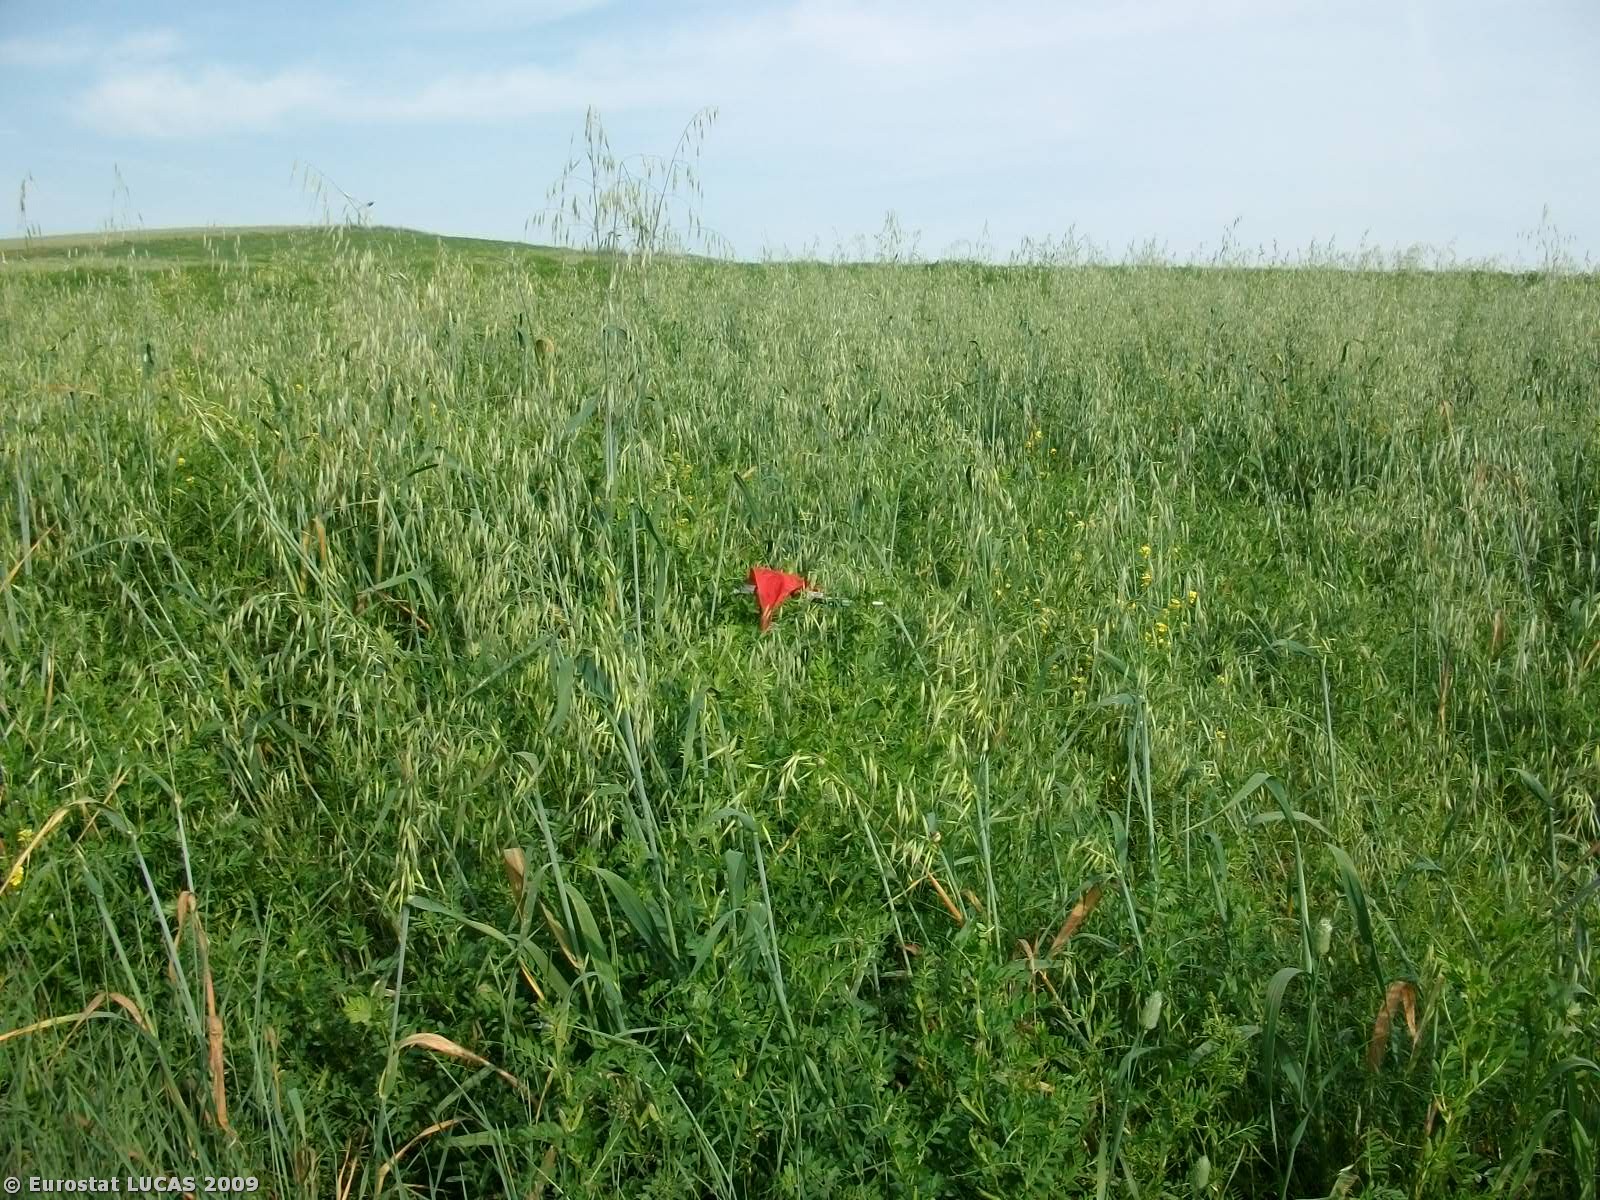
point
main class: Cropland
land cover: Other leguminous and mixtures for fodder
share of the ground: > 75 %
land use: Agriculture (excluding fallow land and kitchen gardens)
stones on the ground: < 10 %
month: May
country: GR
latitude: 39.4249
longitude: 22.3816
